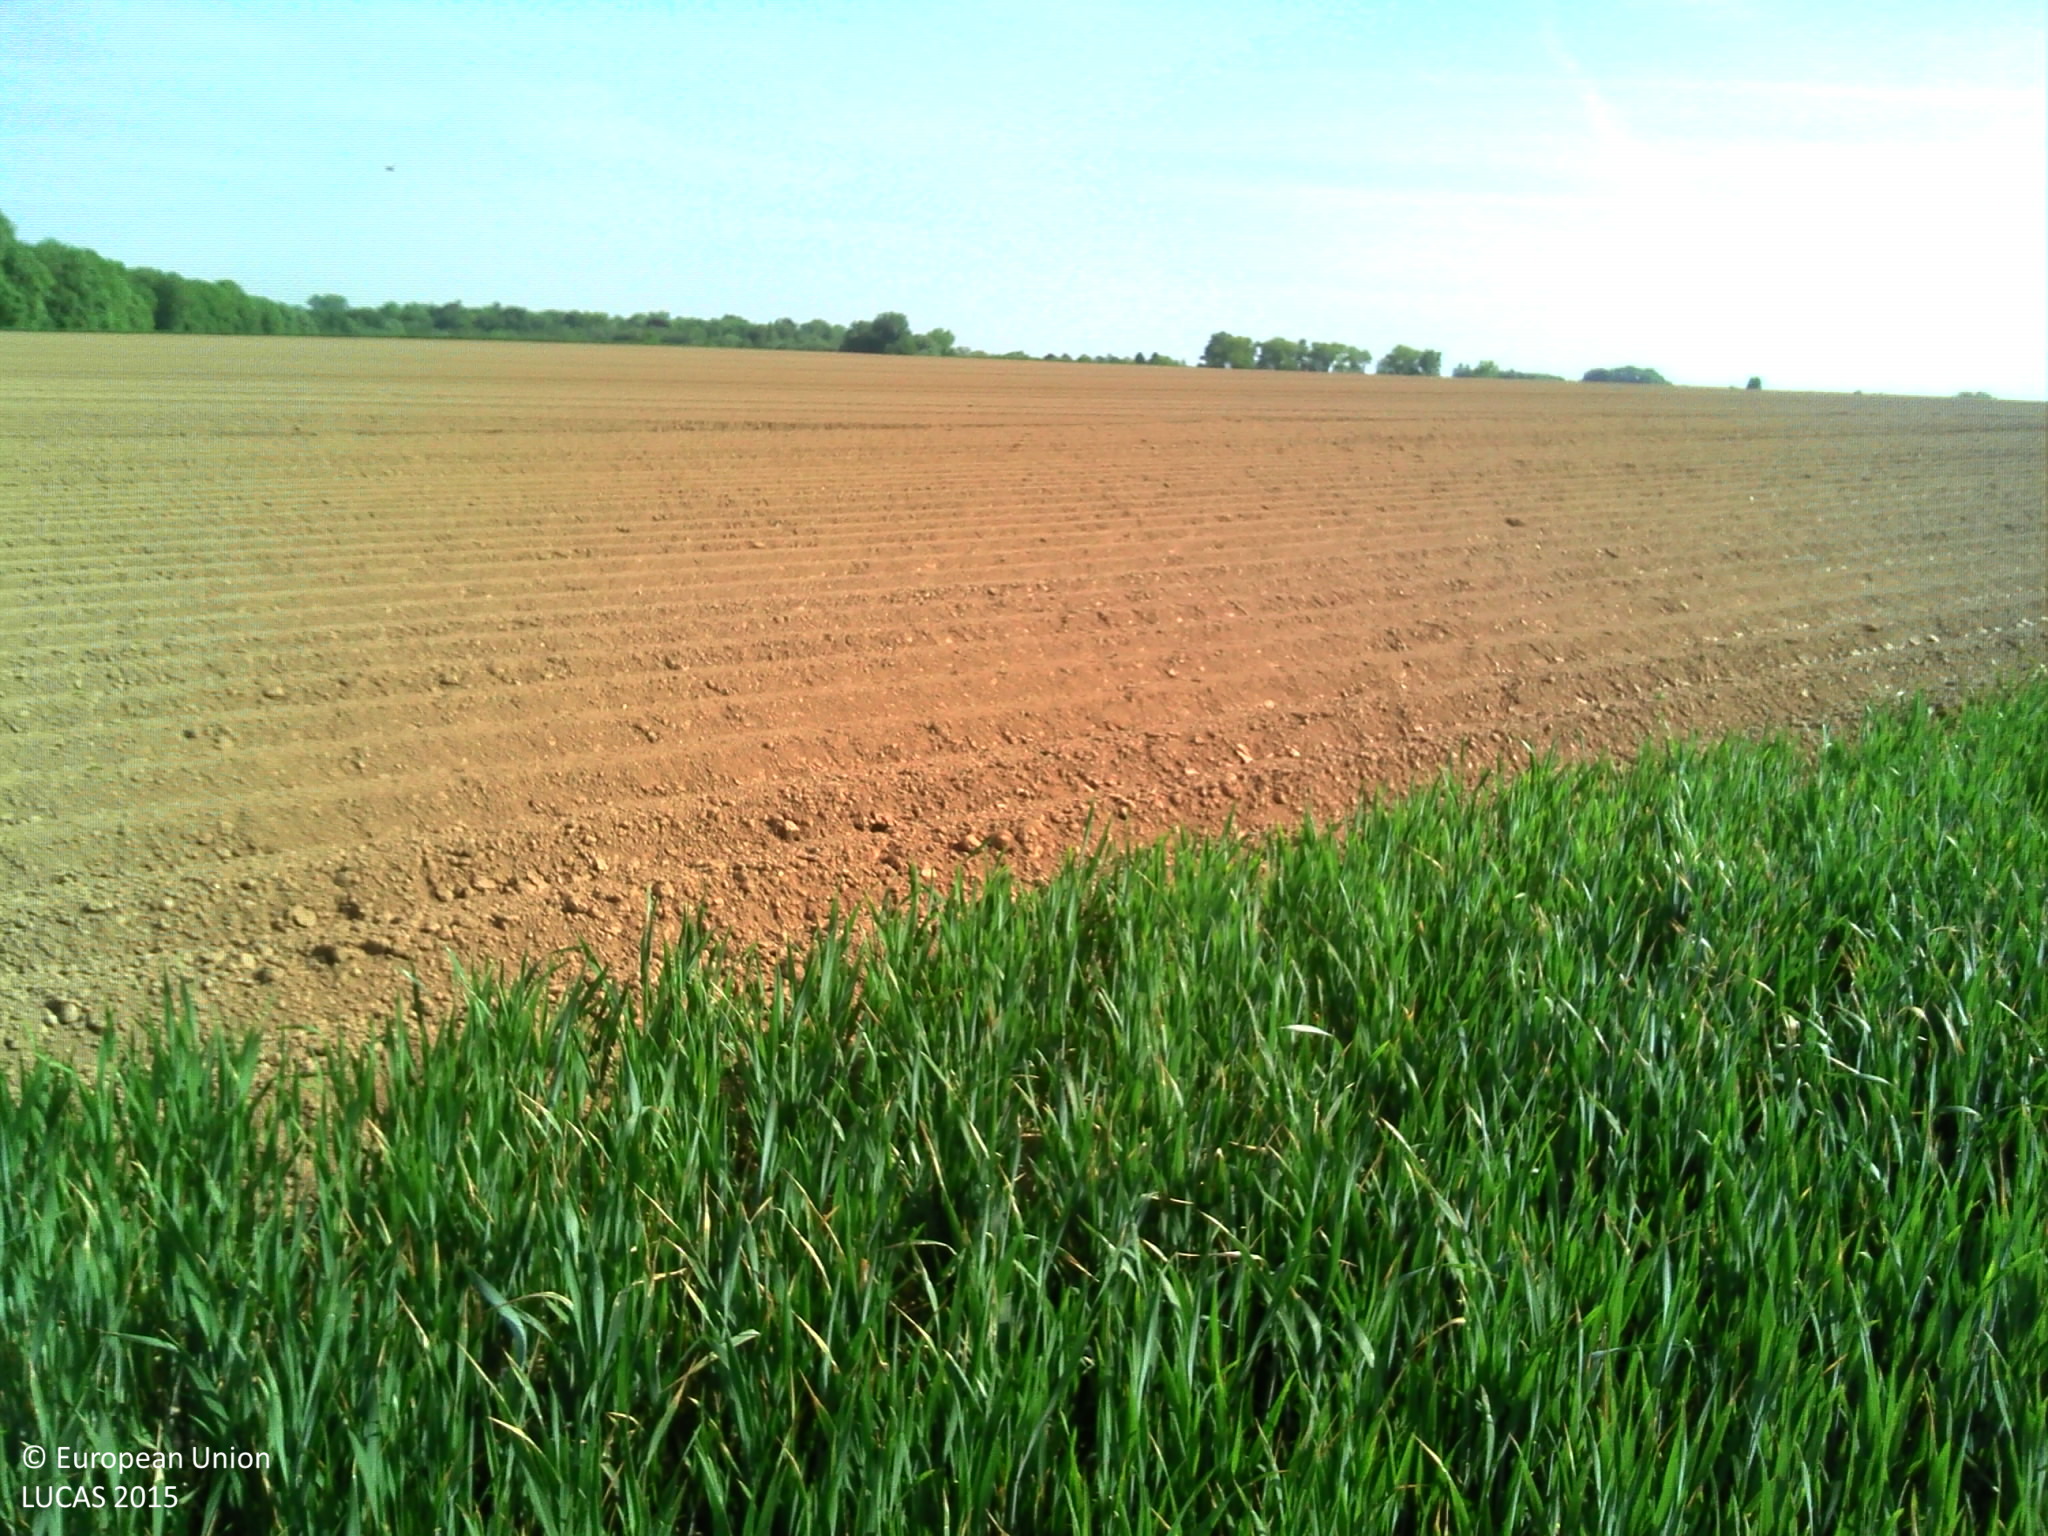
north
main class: Cropland
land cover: Common wheat
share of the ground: > 75 %
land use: Agriculture (excluding fallow land and kitchen gardens)
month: May
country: BE
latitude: 50.5631
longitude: 4.6458
